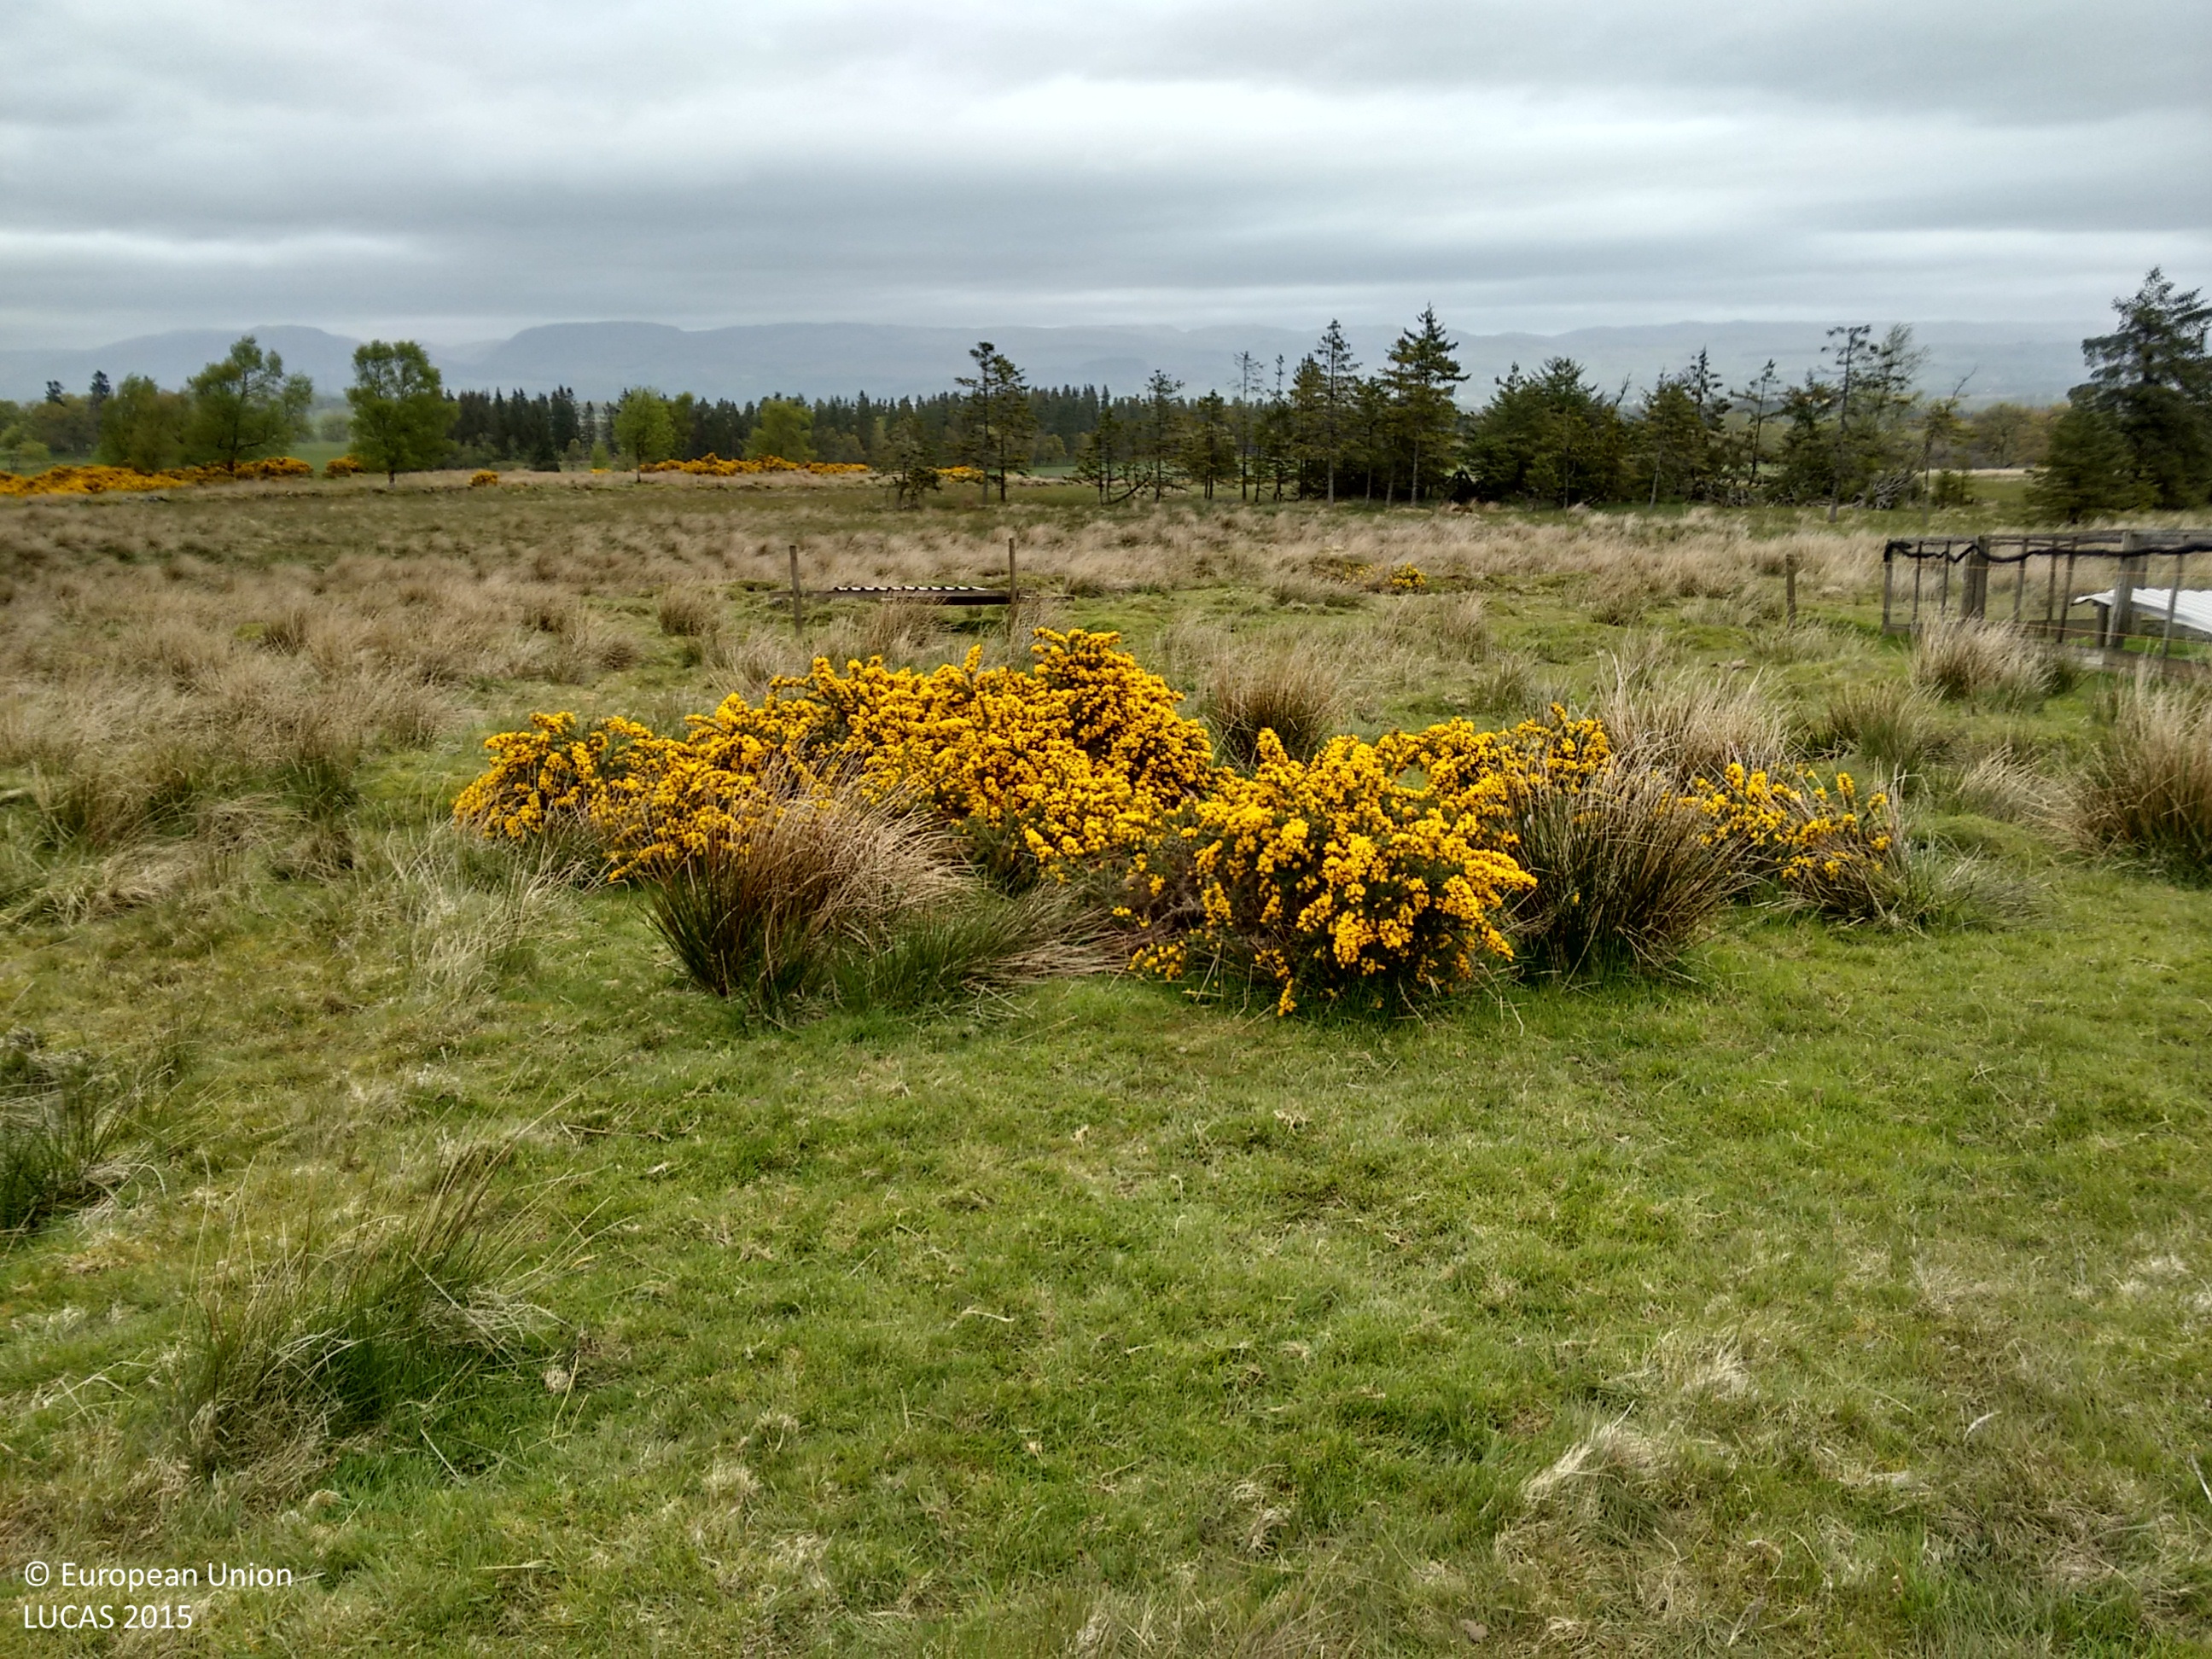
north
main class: Grassland
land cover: Grassland with sparse tree/shrub cover
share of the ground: > 75 %
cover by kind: herbaceous plants 85 %, broadleaved forest trees 5 %, shrubs 5 %, consolidated bare surface 5 %
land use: Agriculture (excluding fallow land and kitchen gardens)
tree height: > 5 m
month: May
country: GB
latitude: 56.2960
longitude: -3.8006
